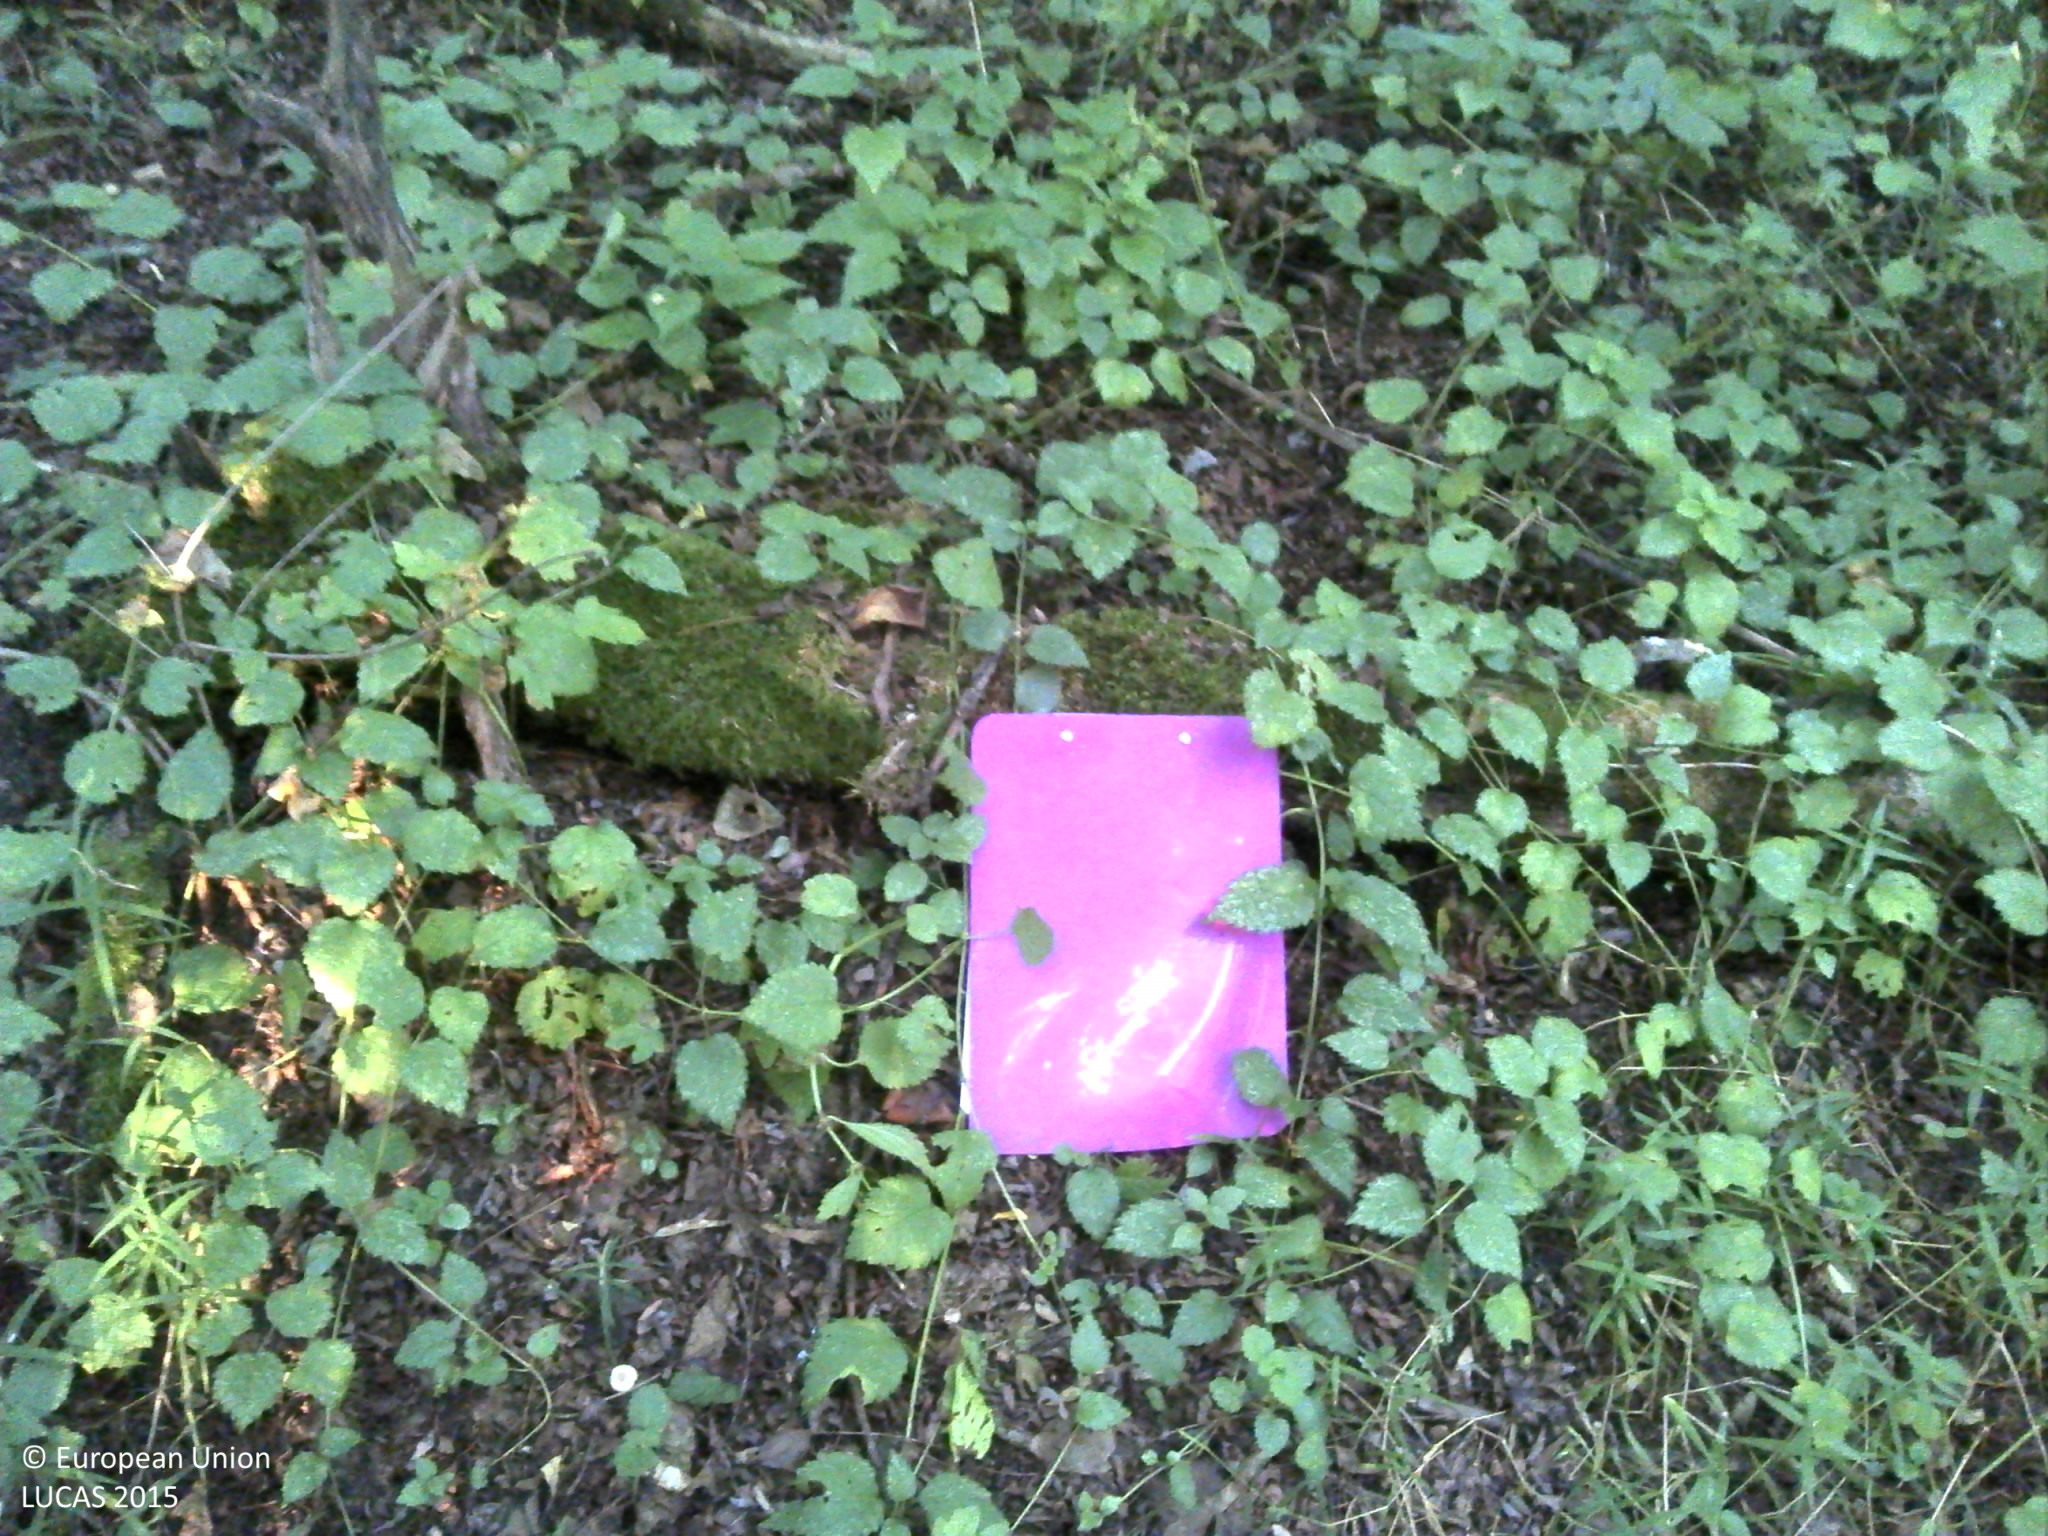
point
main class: Woodland
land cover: Broadleaved woodland
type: acidophilous oak and oak-birch forest
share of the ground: > 75 %
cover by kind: broadleaved forest trees 100 %
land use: Forestry
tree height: > 5 m
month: August
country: HR
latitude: 45.3575
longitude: 16.2138
